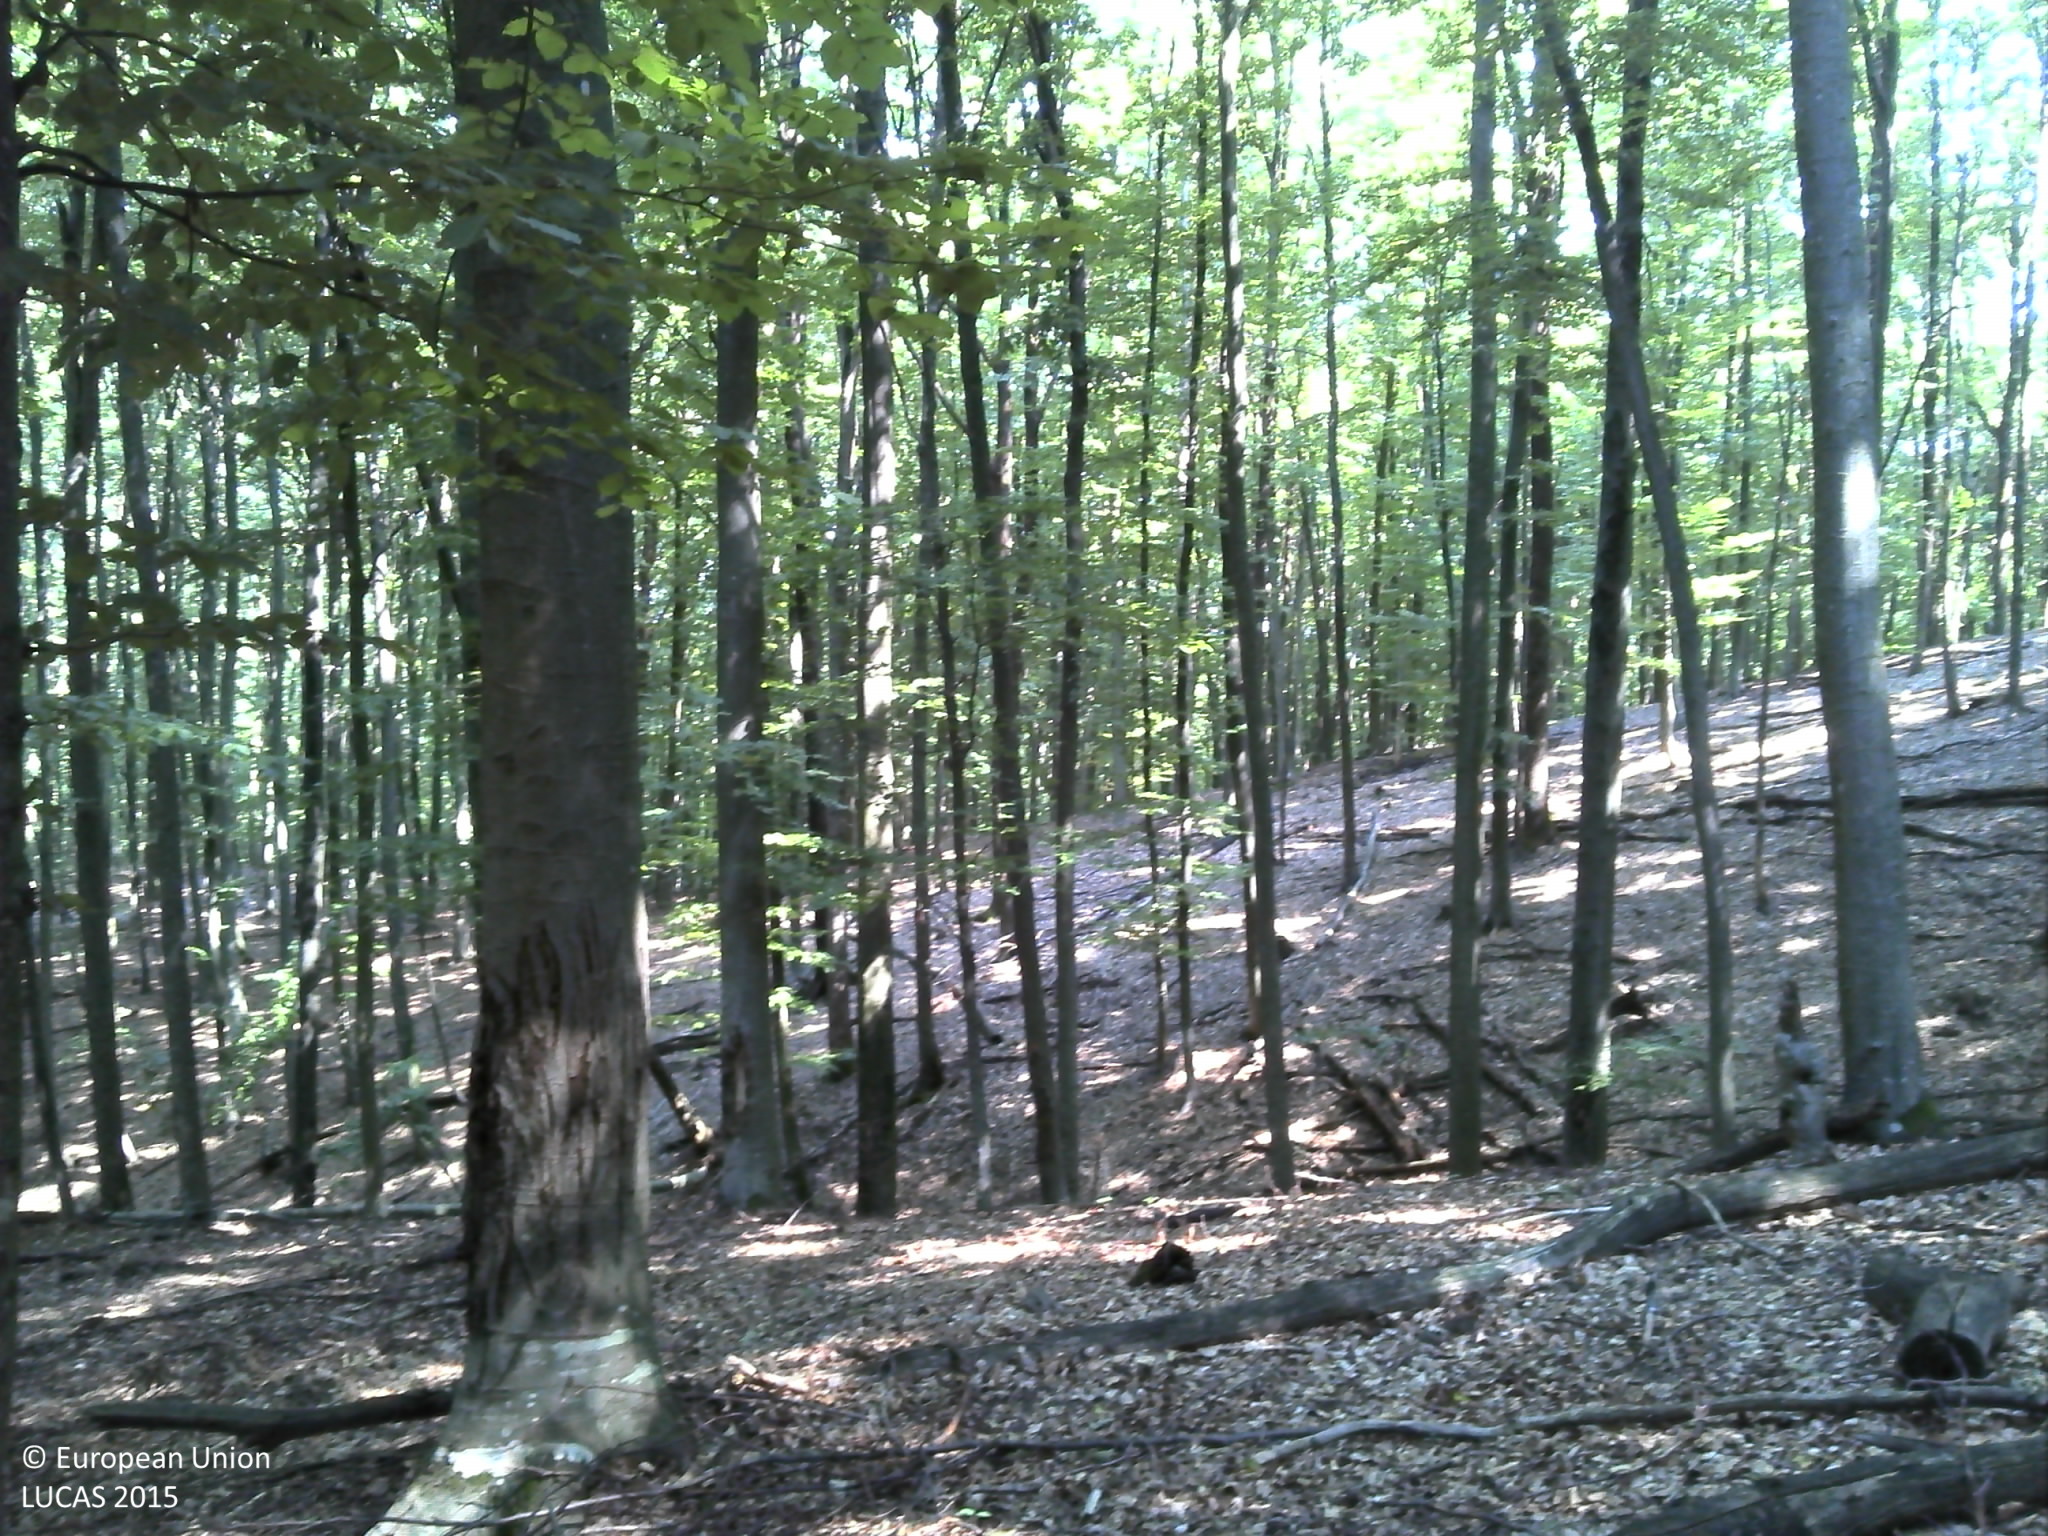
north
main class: Woodland
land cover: Broadleaved woodland
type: acidophilous oak and oak-birch forest
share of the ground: > 75 %
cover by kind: broadleaved forest trees 80 %, lichens and mosses 20 %
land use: Forestry
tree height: > 5 m
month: July
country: HR
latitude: 45.5790
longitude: 16.7273
